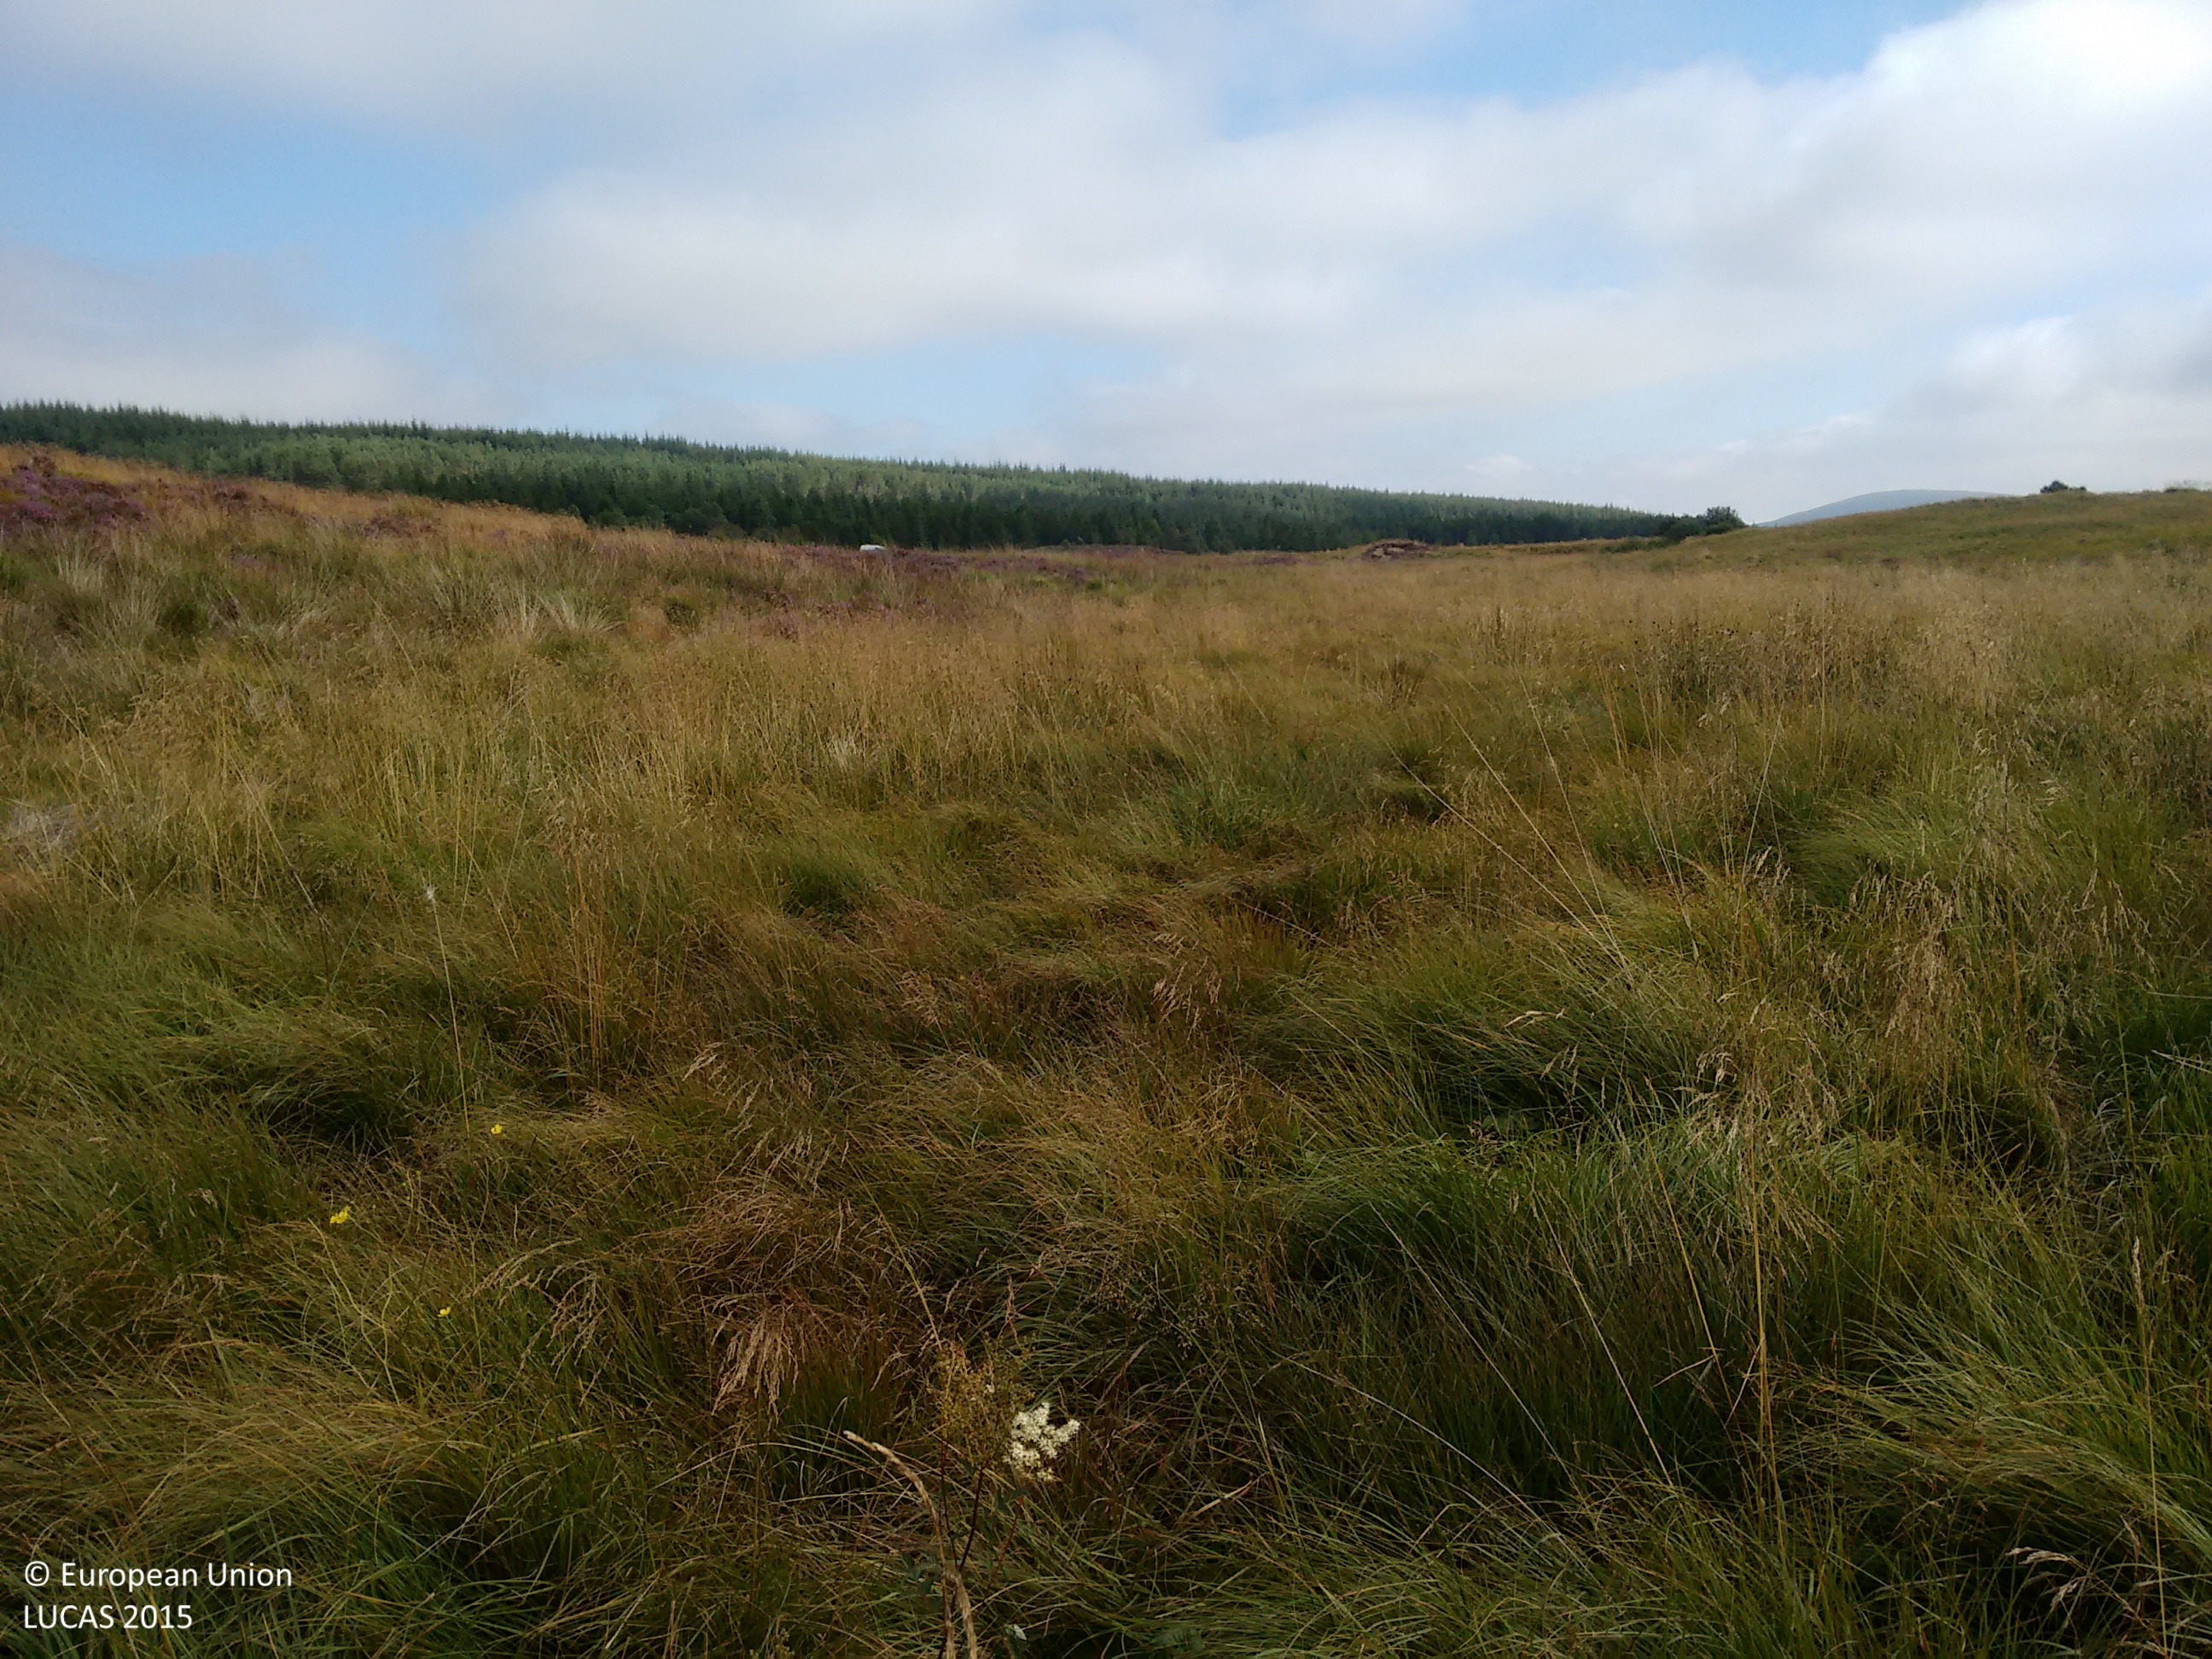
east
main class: Grassland
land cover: Grassland without tree/shrub cover
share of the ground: > 75 %
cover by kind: herbaceous plants 100 %
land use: Agriculture (excluding fallow land and kitchen gardens)
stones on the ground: < 10 %
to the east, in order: Grassland without tree/shrub cover; Rivers and streams; Grassland without tree/shrub cover; Shrubland without tree cover; Grassland without tree/shrub cover; Shrubland without tree cover
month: September
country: GB
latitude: 58.0991
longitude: -4.3876
